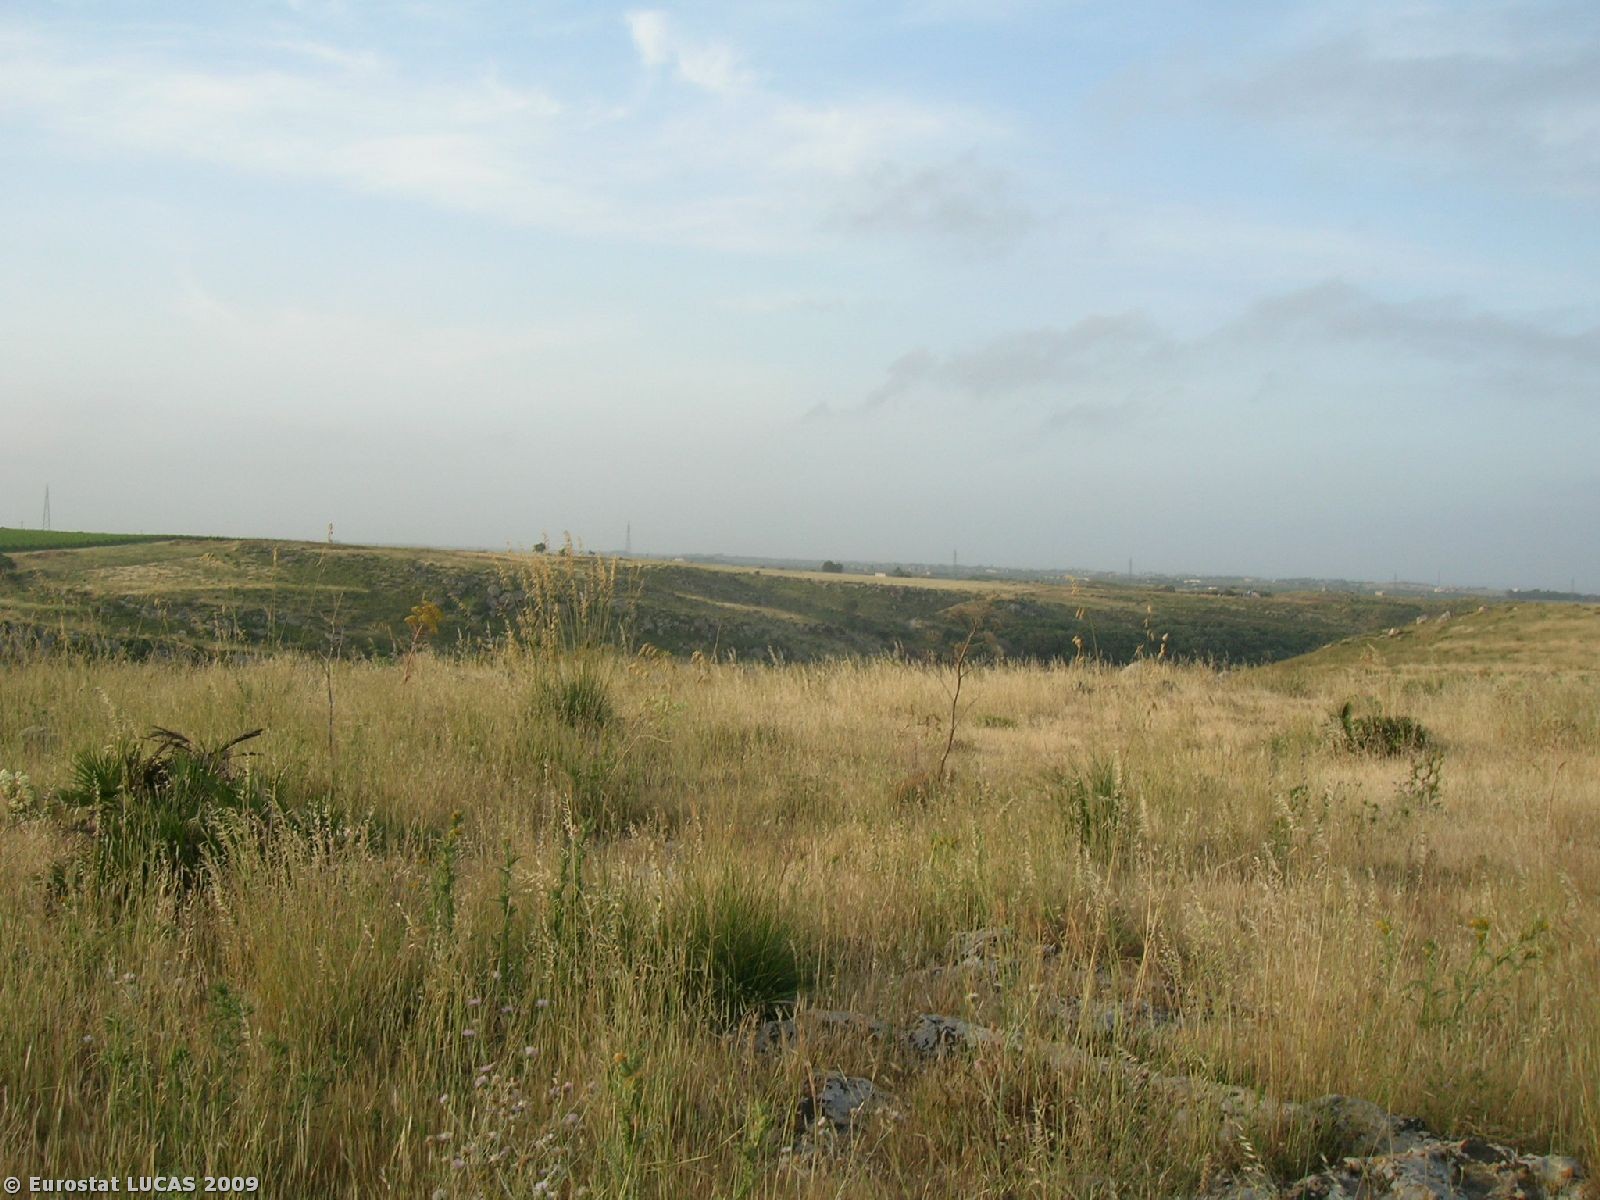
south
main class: Shrubland
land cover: Shrubland without tree cover
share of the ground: > 75 %
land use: Nature reserves
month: May
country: IT
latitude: 37.7114
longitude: 12.6232
